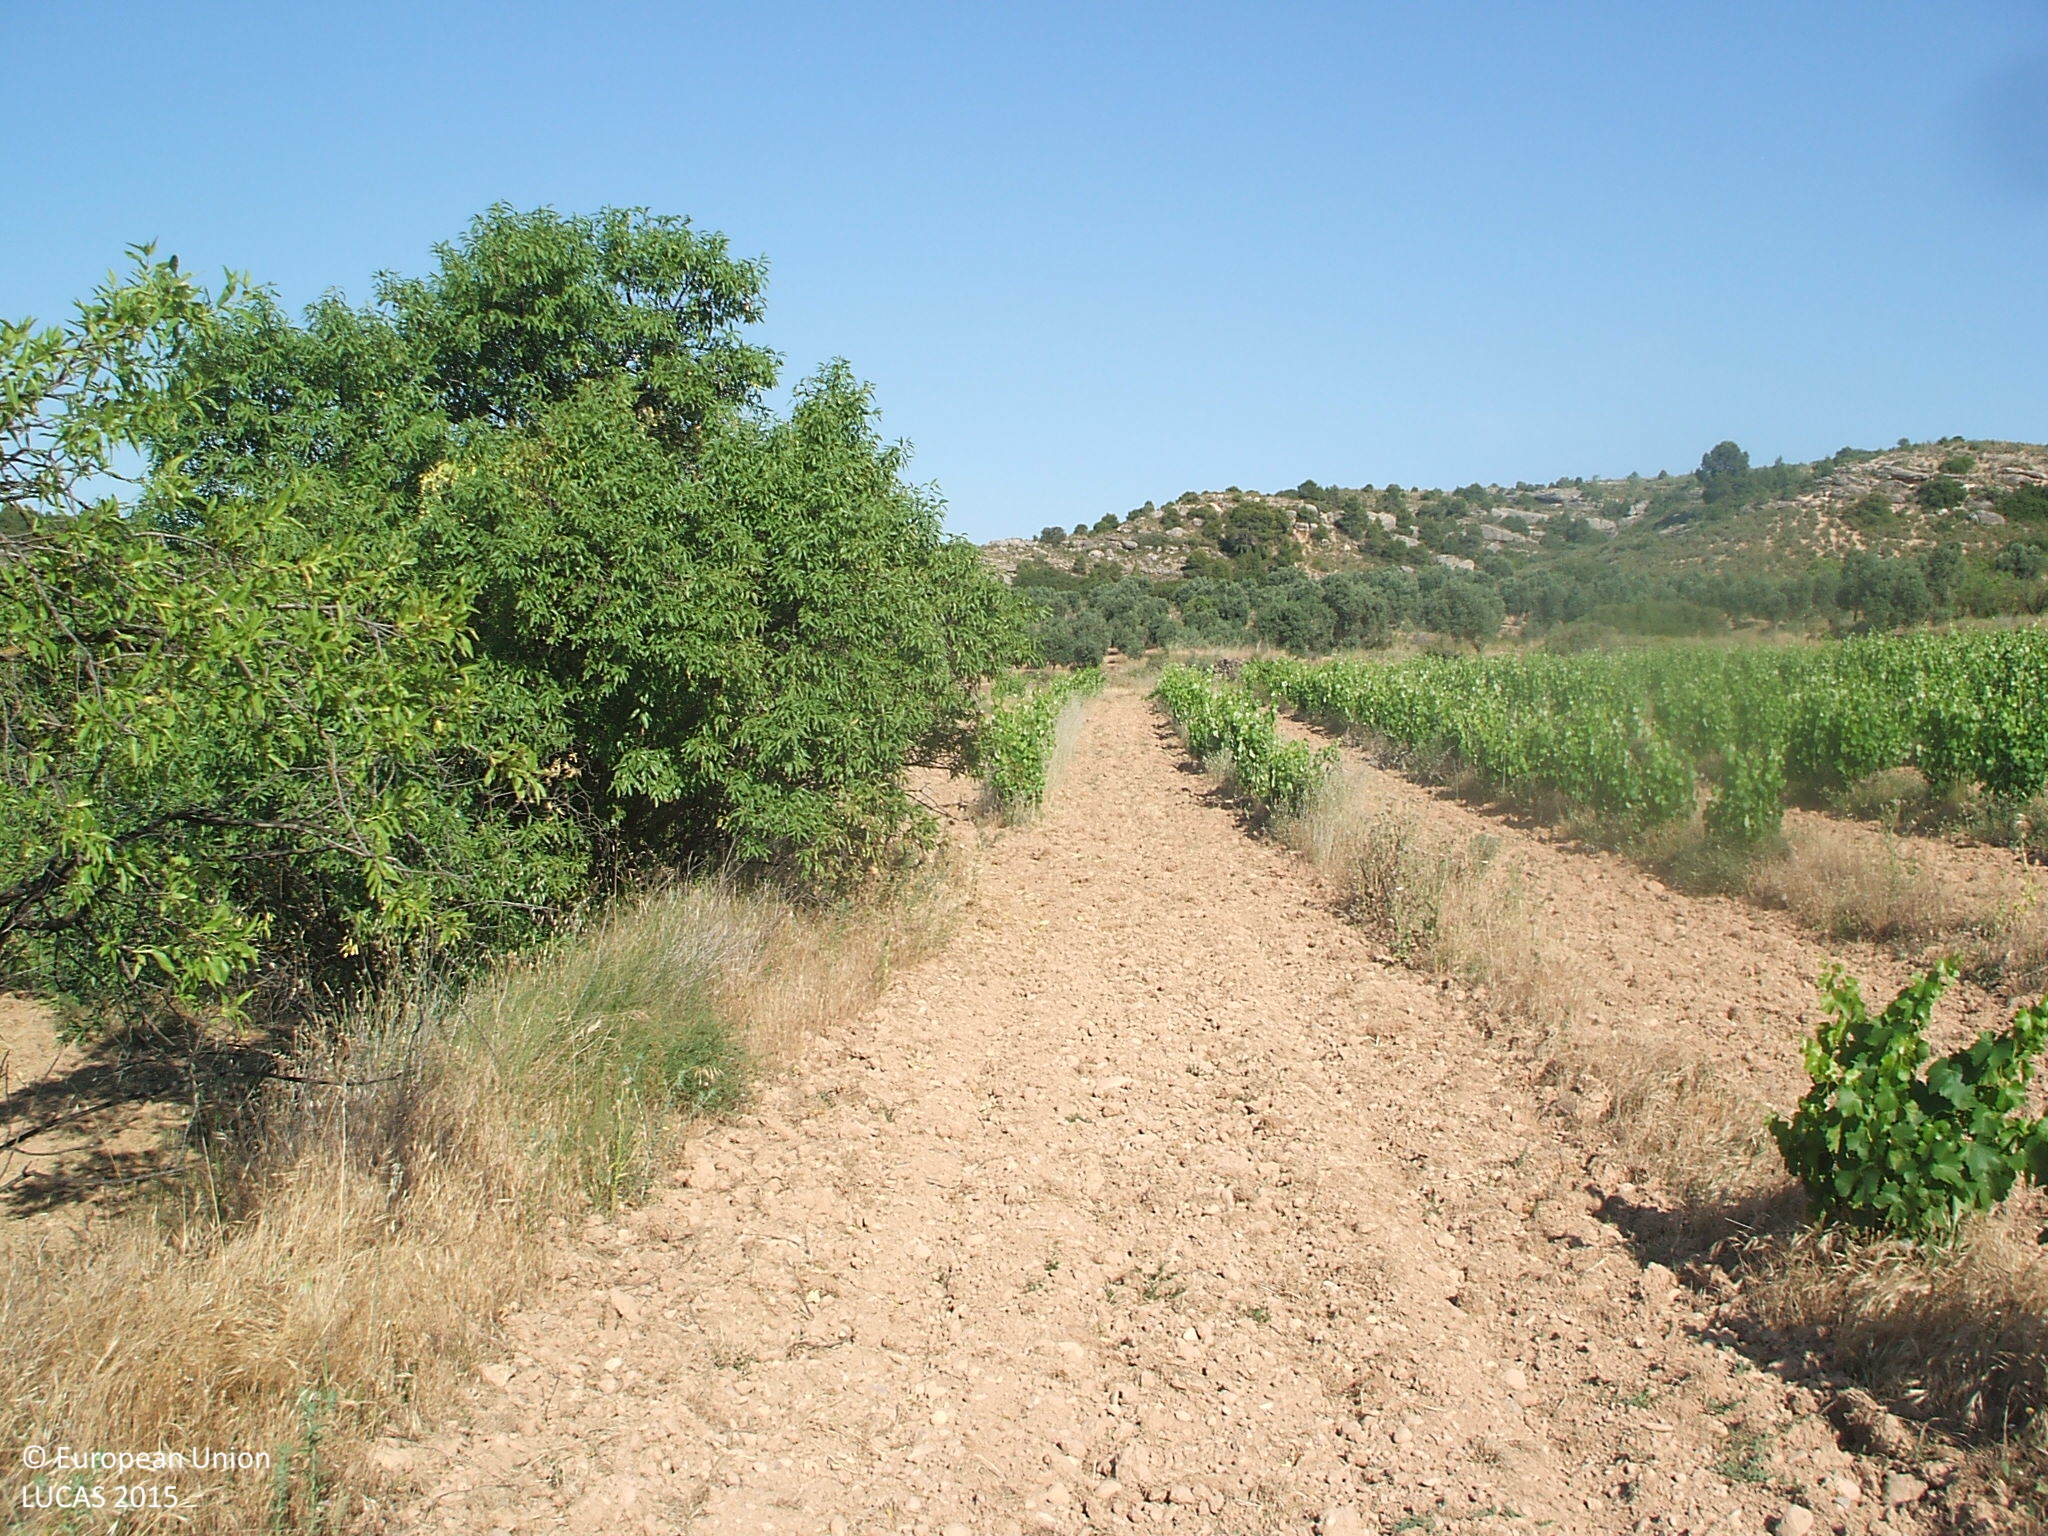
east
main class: Cropland
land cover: Vineyards
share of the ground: 10 - 25 %
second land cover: Other bare soil
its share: > 75 %
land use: Agriculture (excluding fallow land and kitchen gardens)
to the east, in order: Vineyards; Other bare soil; Vineyards; Other bare soil; Vineyards; Grass margins; Abandoned hedges; Olive groves; Spontaneously vegetated surfaces; Shruby margins; Olive groves; Shruby margins; Shrubland with sparse tree cover; Spontaneously vegetated surfaces; Tracks; Grass margins; Olive groves; Grass margins; Dry stone walls; Grass margins; Olive groves
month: June
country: ES
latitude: 40.9808
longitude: -0.1249
